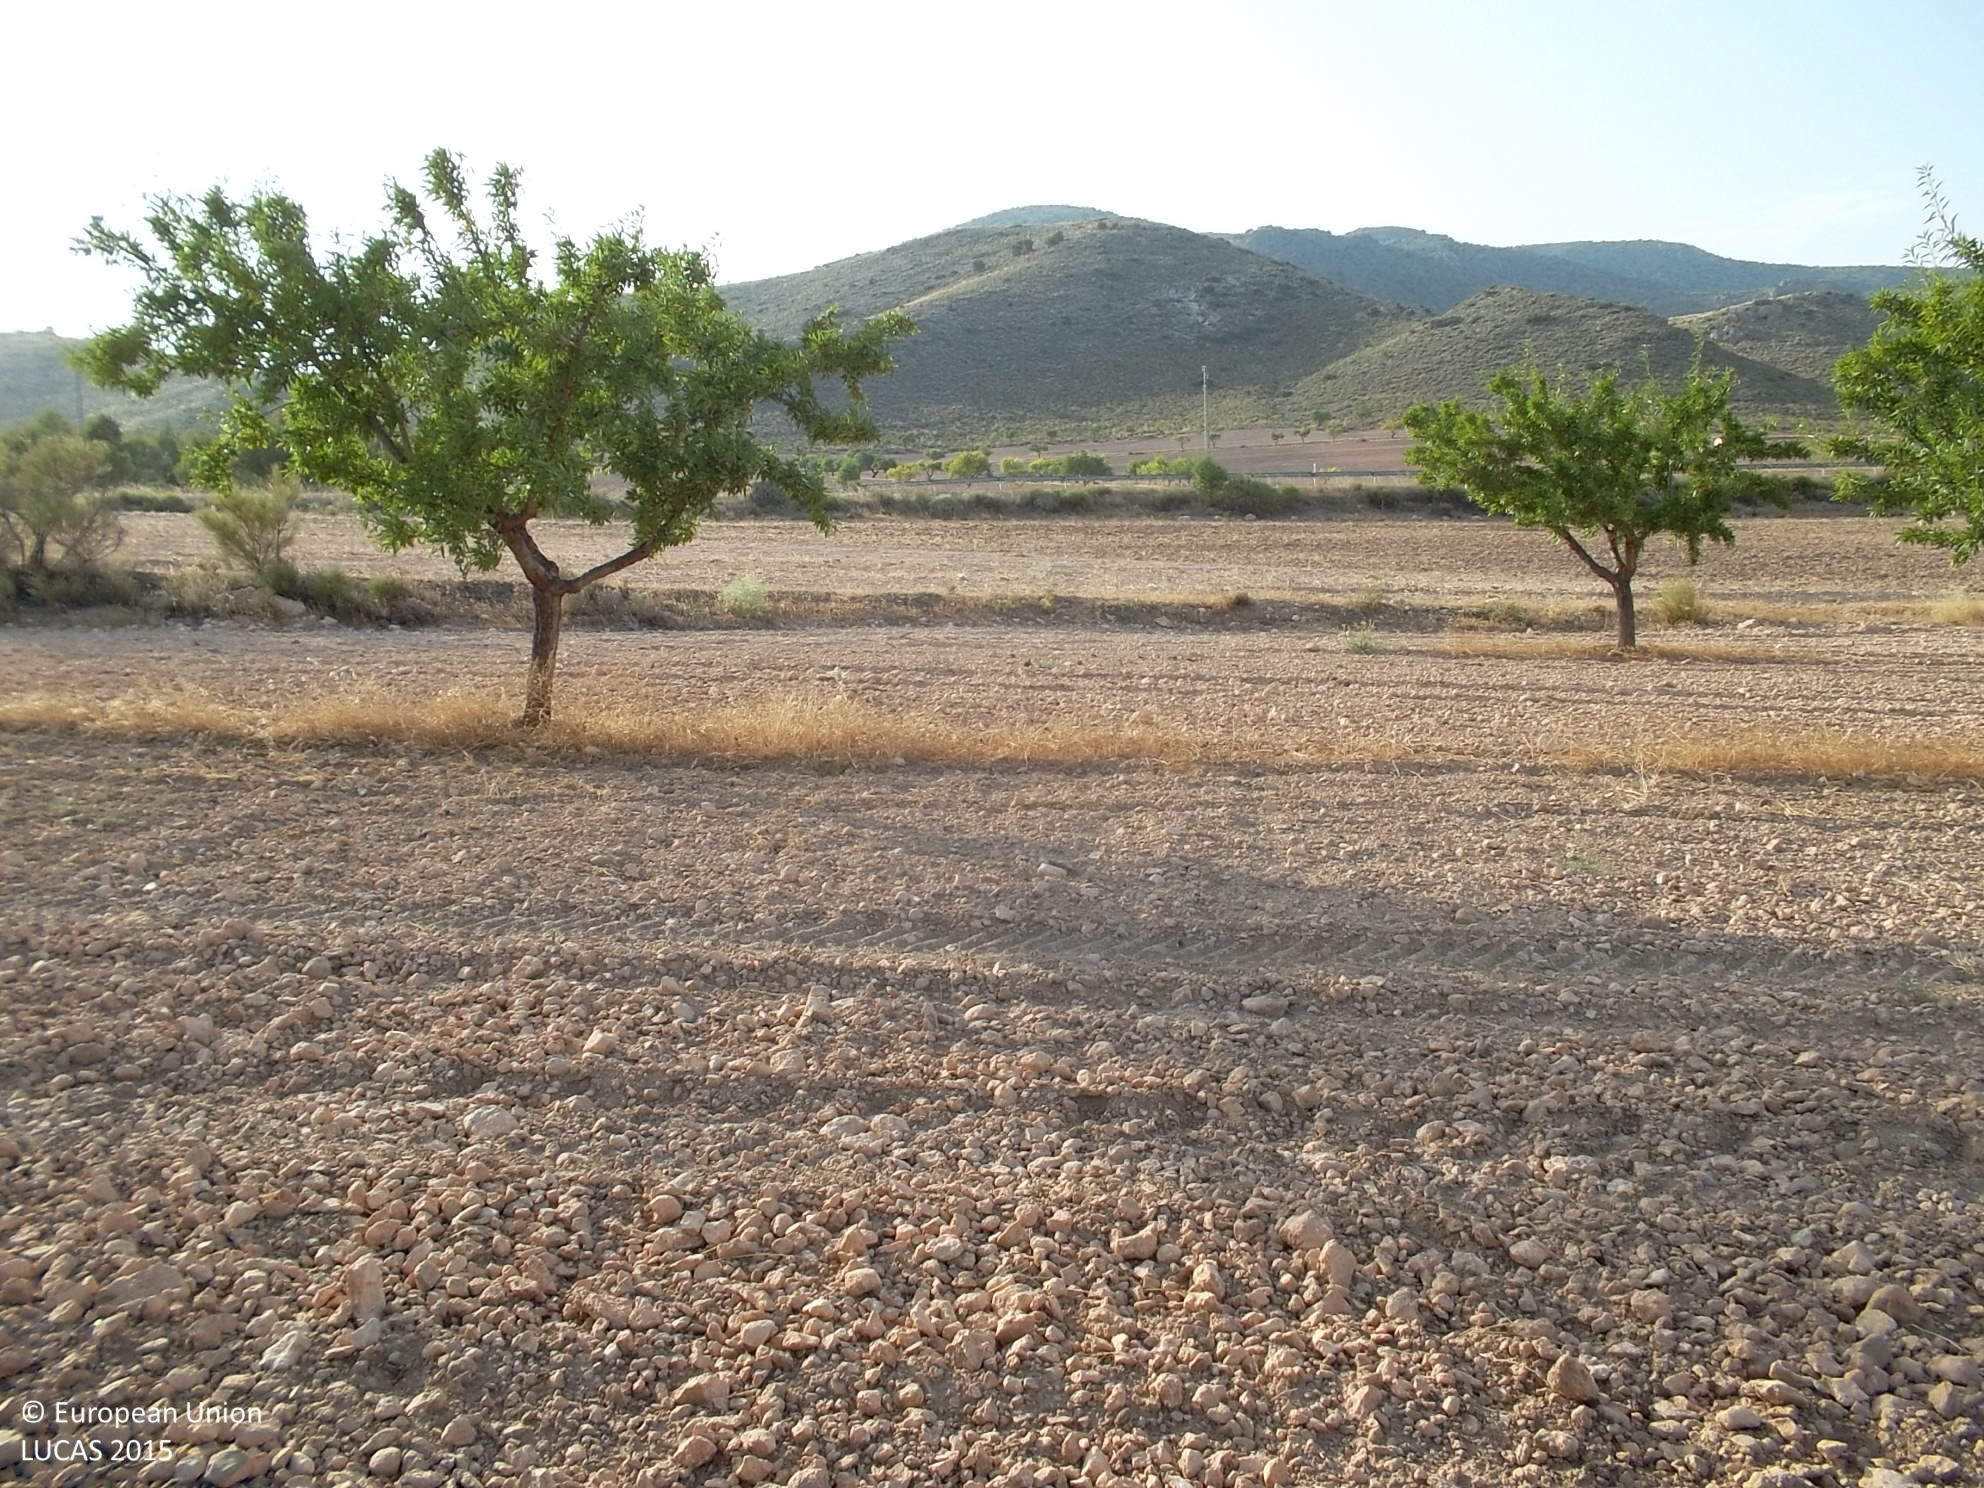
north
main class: Cropland
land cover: Nuts trees
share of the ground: 25 - 50 %
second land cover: Other bare soil
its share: > 75 %
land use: Agriculture (excluding fallow land and kitchen gardens)
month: July
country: ES
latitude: 37.8206
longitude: -2.4745
